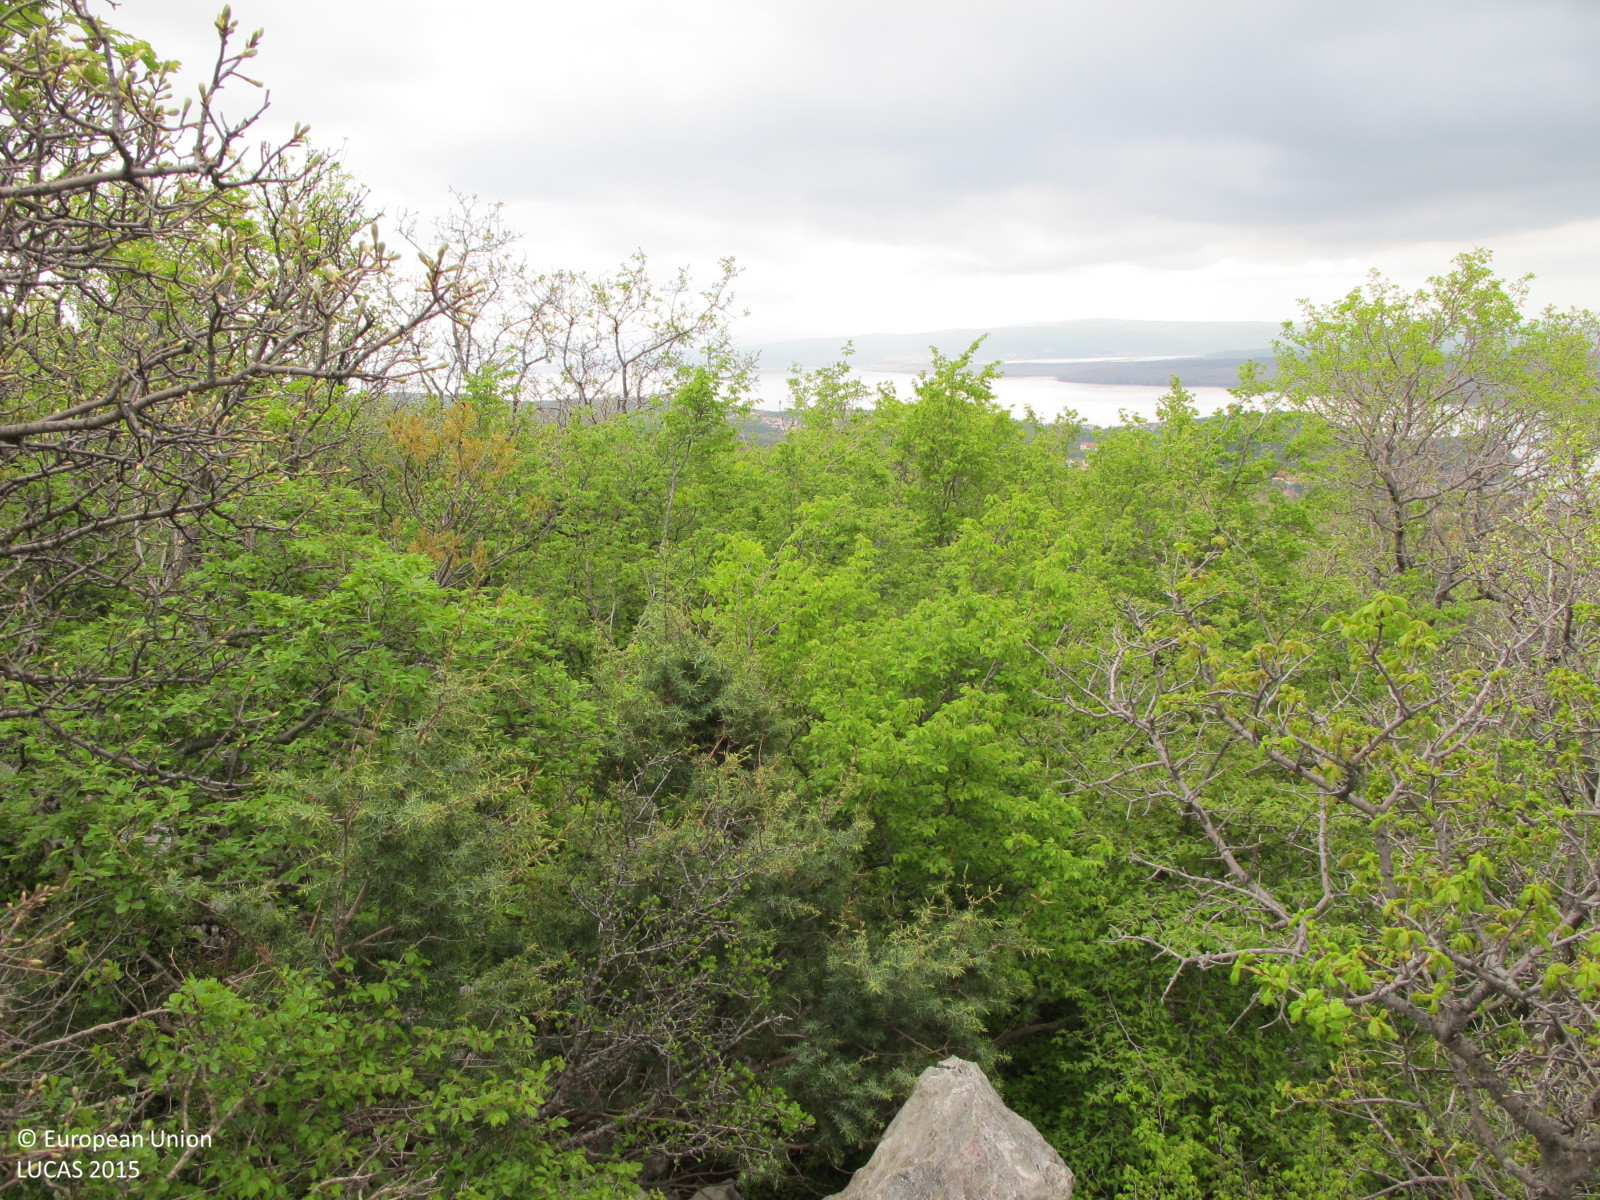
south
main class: Woodland
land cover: Broadleaved woodland
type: thermophilous deciduous forest
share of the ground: > 75 %
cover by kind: broadleaved forest trees 75 %, shrubs 20 %
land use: Semi-natural and natural areas not in use
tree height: < 5 m
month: April
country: HR
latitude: 45.2409
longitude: 14.6192
